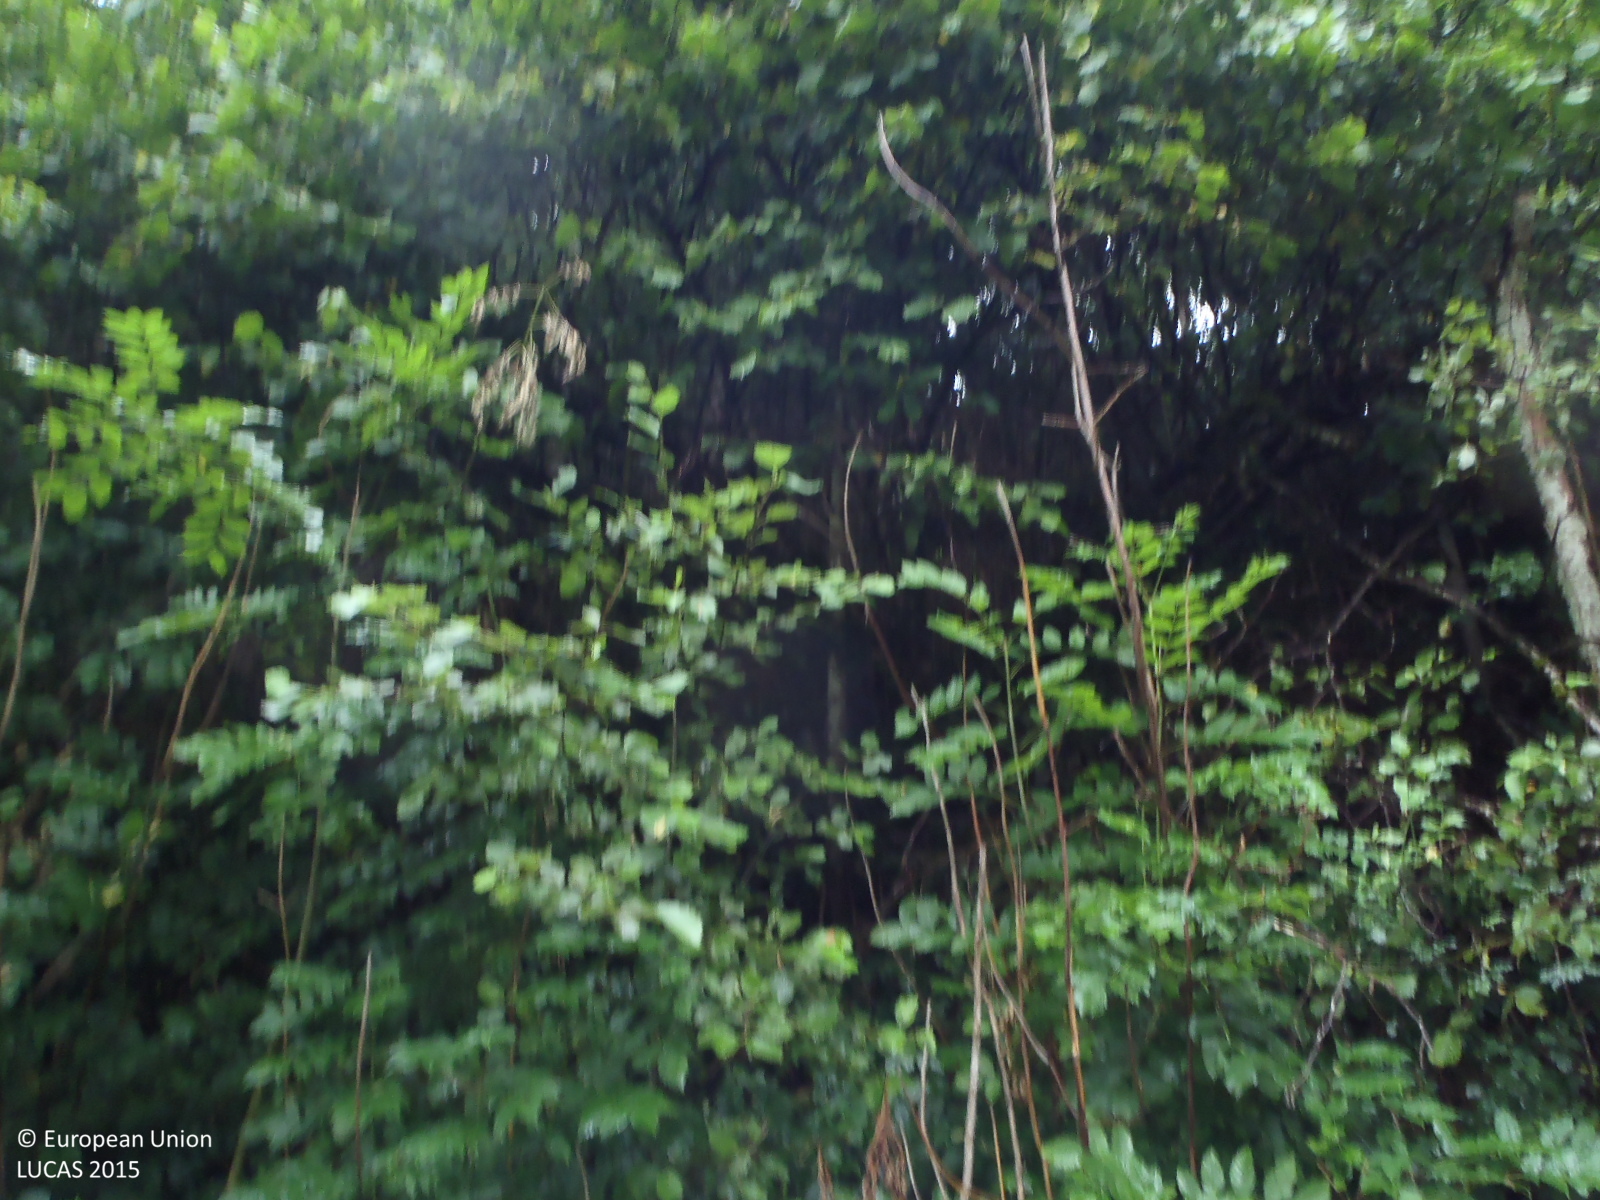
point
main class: Woodland
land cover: Spruce dominated mixed woodland
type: alpine coniferous forest
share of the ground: > 75 %
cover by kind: broadleaved forest trees 70 %, coniferous forest trees 30 %
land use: Forestry
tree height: > 5 m
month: July
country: AT
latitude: 47.1816
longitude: 11.8590
